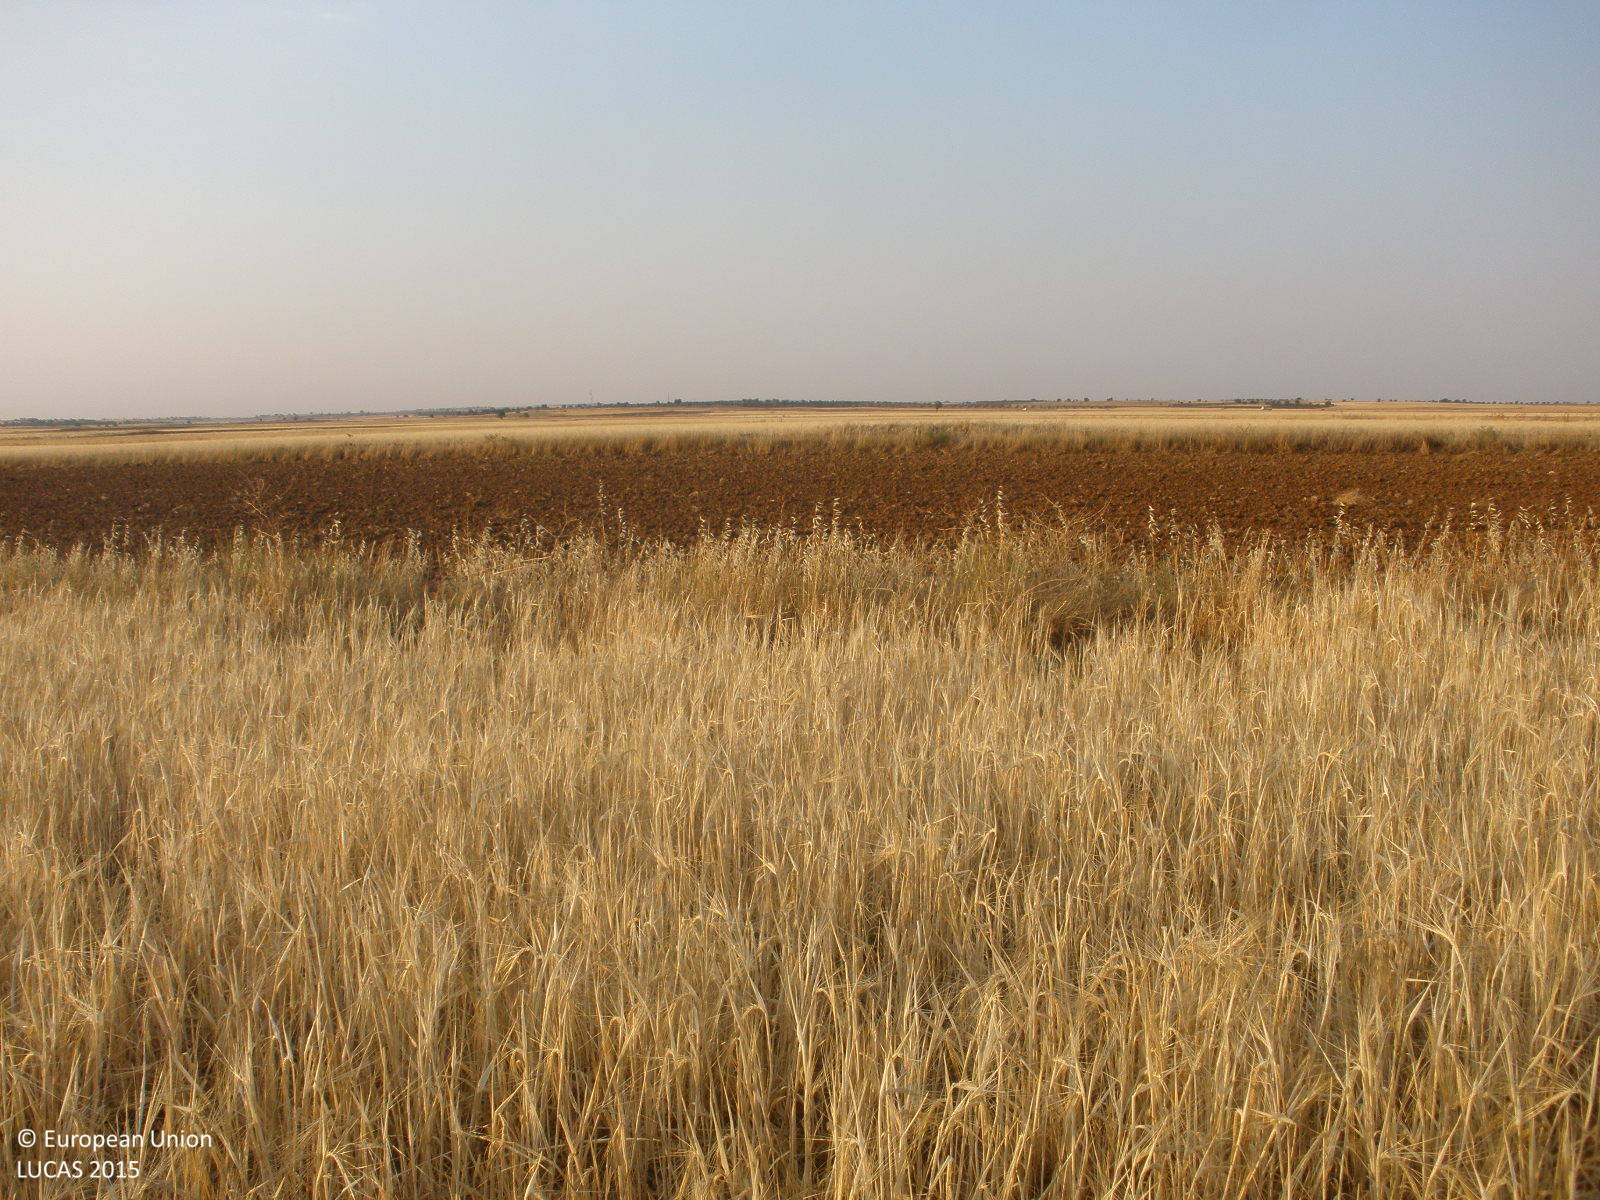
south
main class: Cropland
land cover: Barley
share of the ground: > 75 %
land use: Agriculture (excluding fallow land and kitchen gardens)
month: June
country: ES
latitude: 40.3397
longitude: -3.3459
